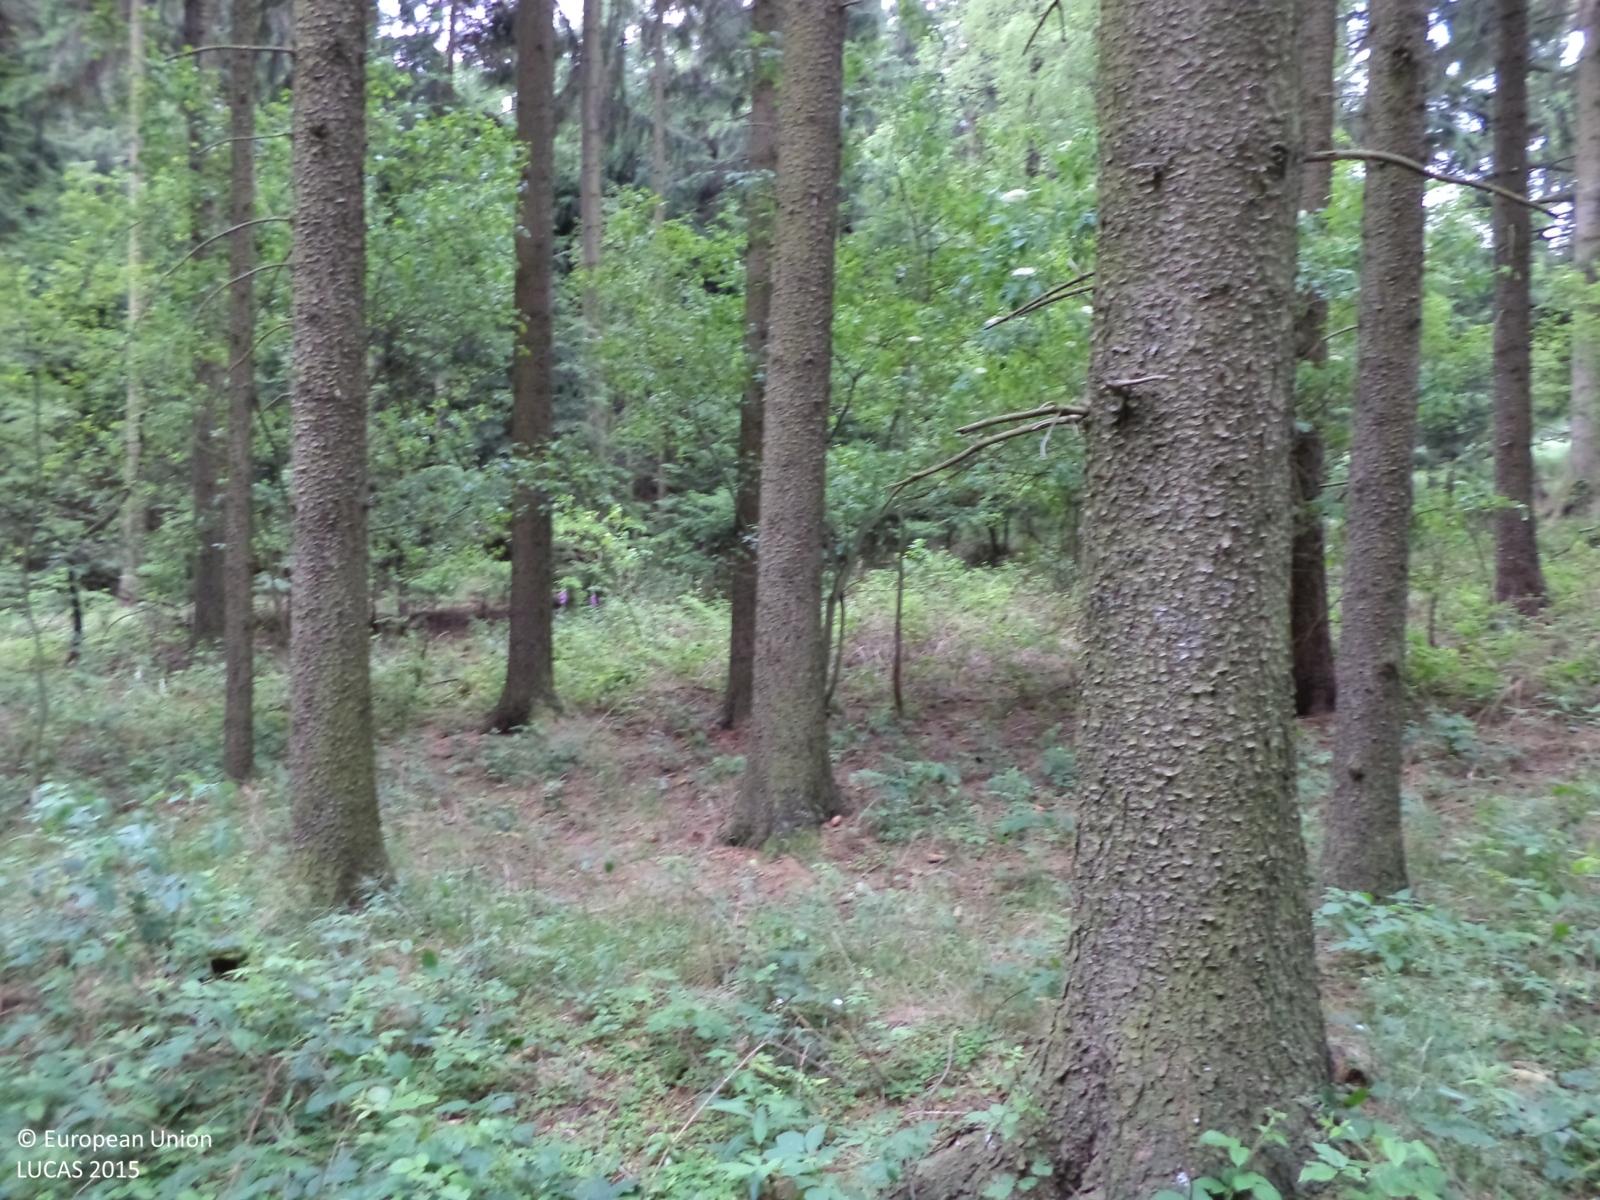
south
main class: Woodland
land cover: Spruce dominated coniferous woodland
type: hemiboreal forest and nemoral coniferous forest and mixed broadleaved-coniferous forest
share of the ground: > 75 %
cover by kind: coniferous forest trees 90 %, shrubs 5 %, herbaceous plants 5 %
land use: Forestry
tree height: > 5 m
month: June
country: CZ
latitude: 49.5728
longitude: 14.9392
